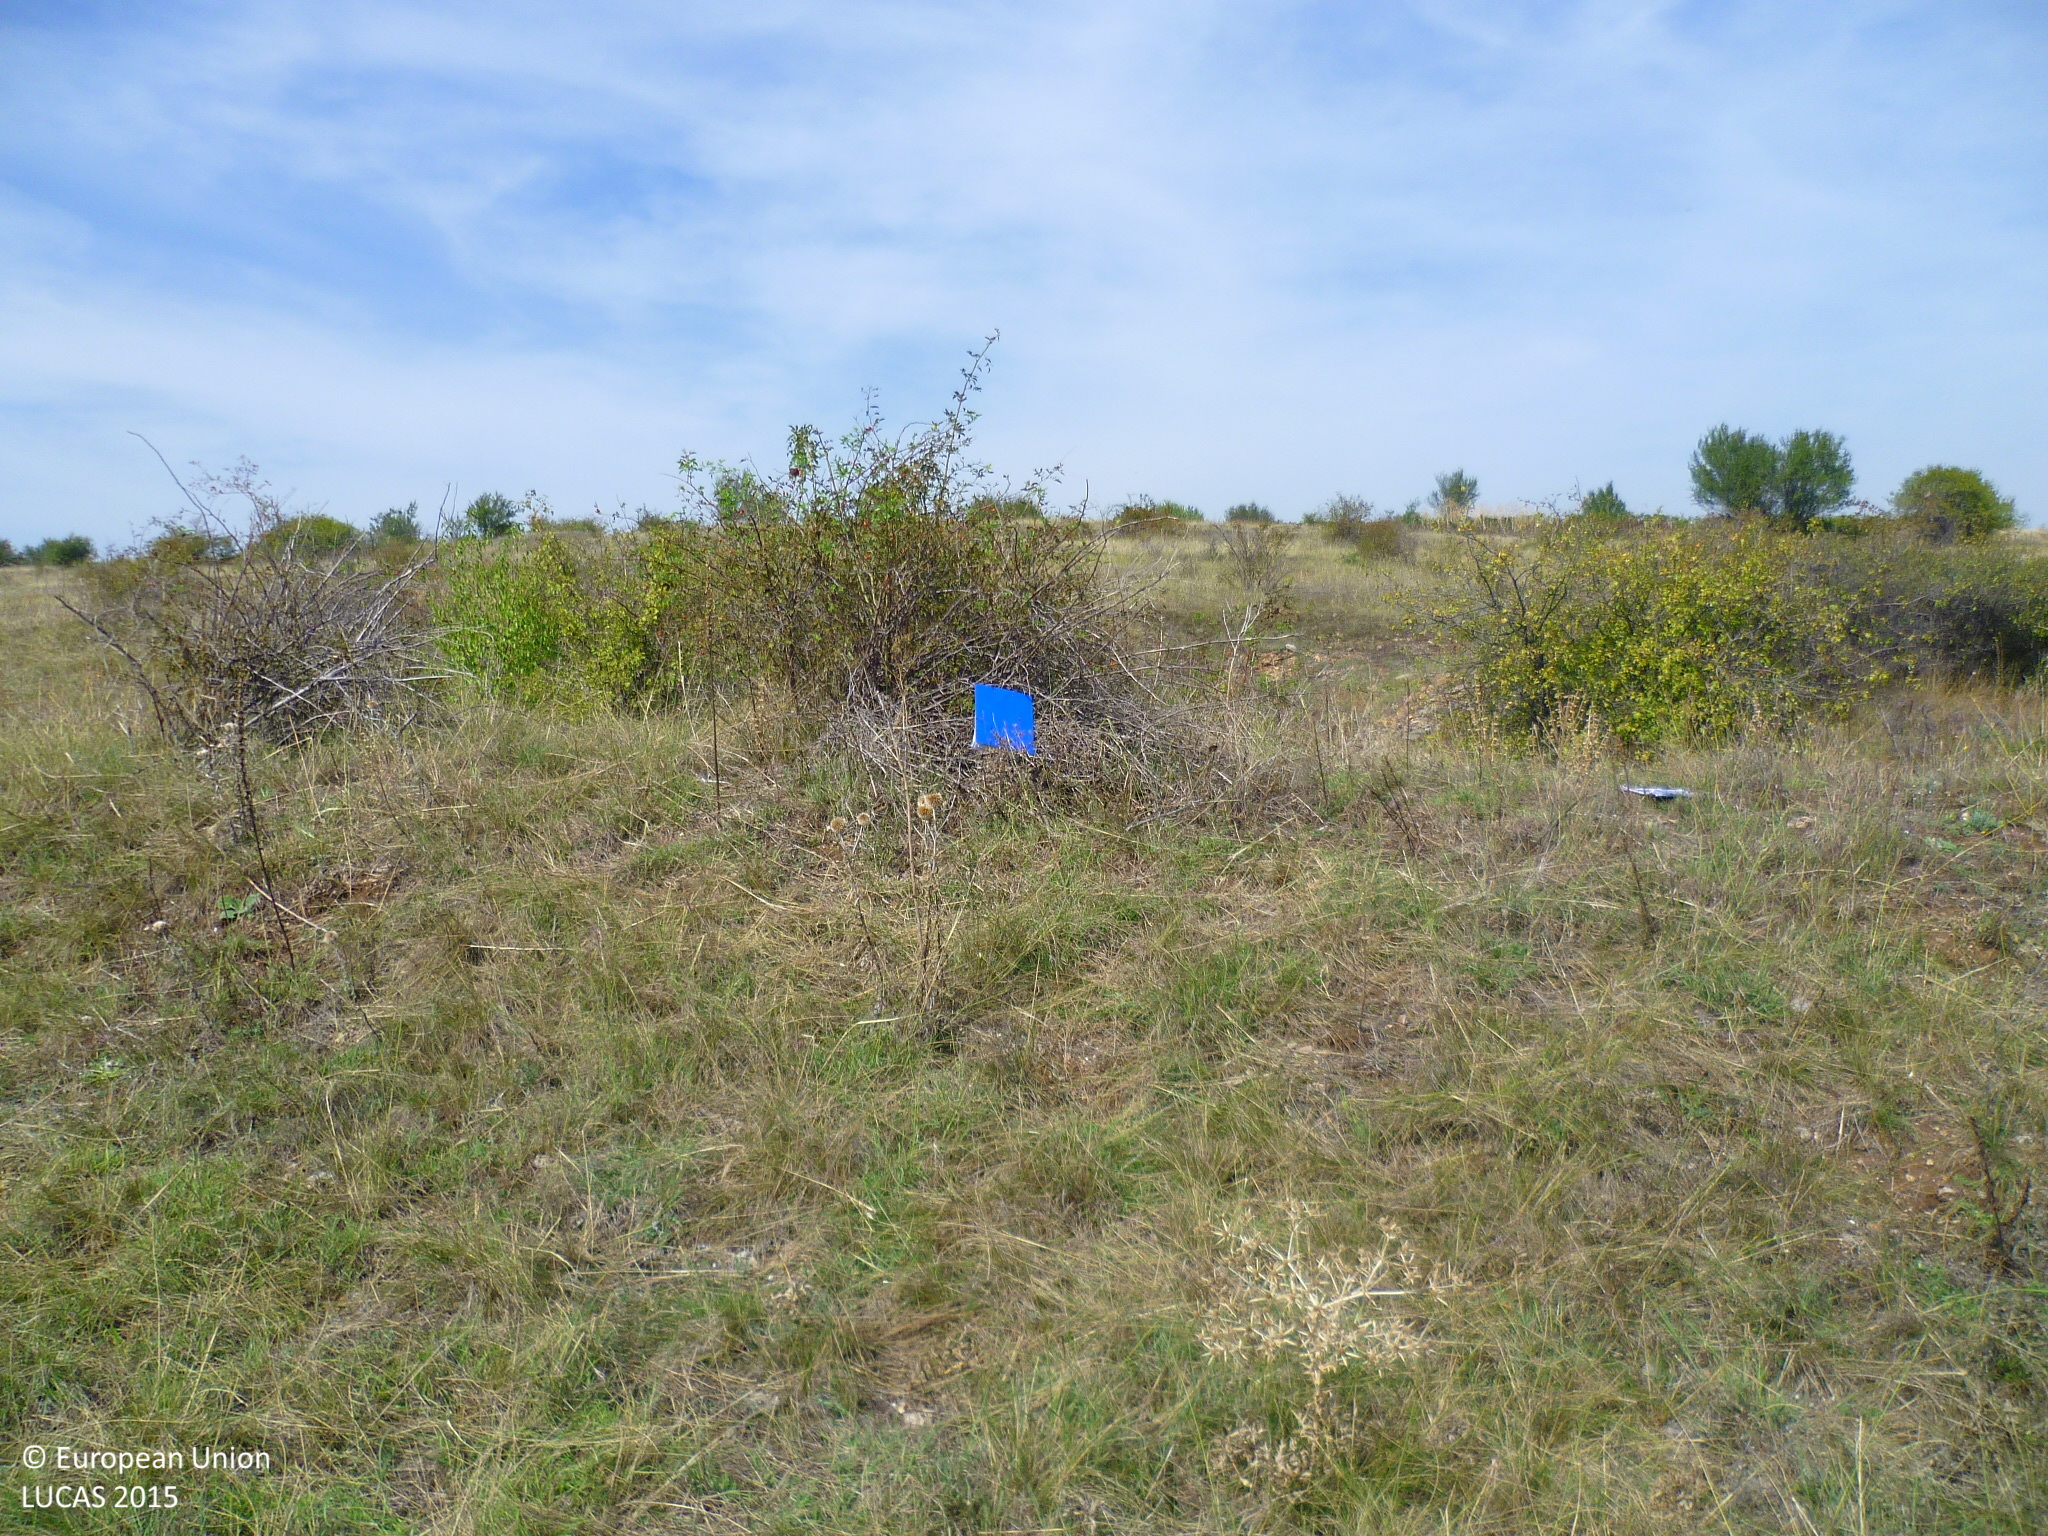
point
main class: Grassland
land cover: Grassland with sparse tree/shrub cover
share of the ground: > 75 %
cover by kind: herbaceous plants 90 %, broadleaved forest trees 5 %, shrubs 5 %
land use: Agriculture (excluding fallow land and kitchen gardens)
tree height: < 5 m
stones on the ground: 10 - 25 %
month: September
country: BG
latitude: 42.8598
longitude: 23.0915
